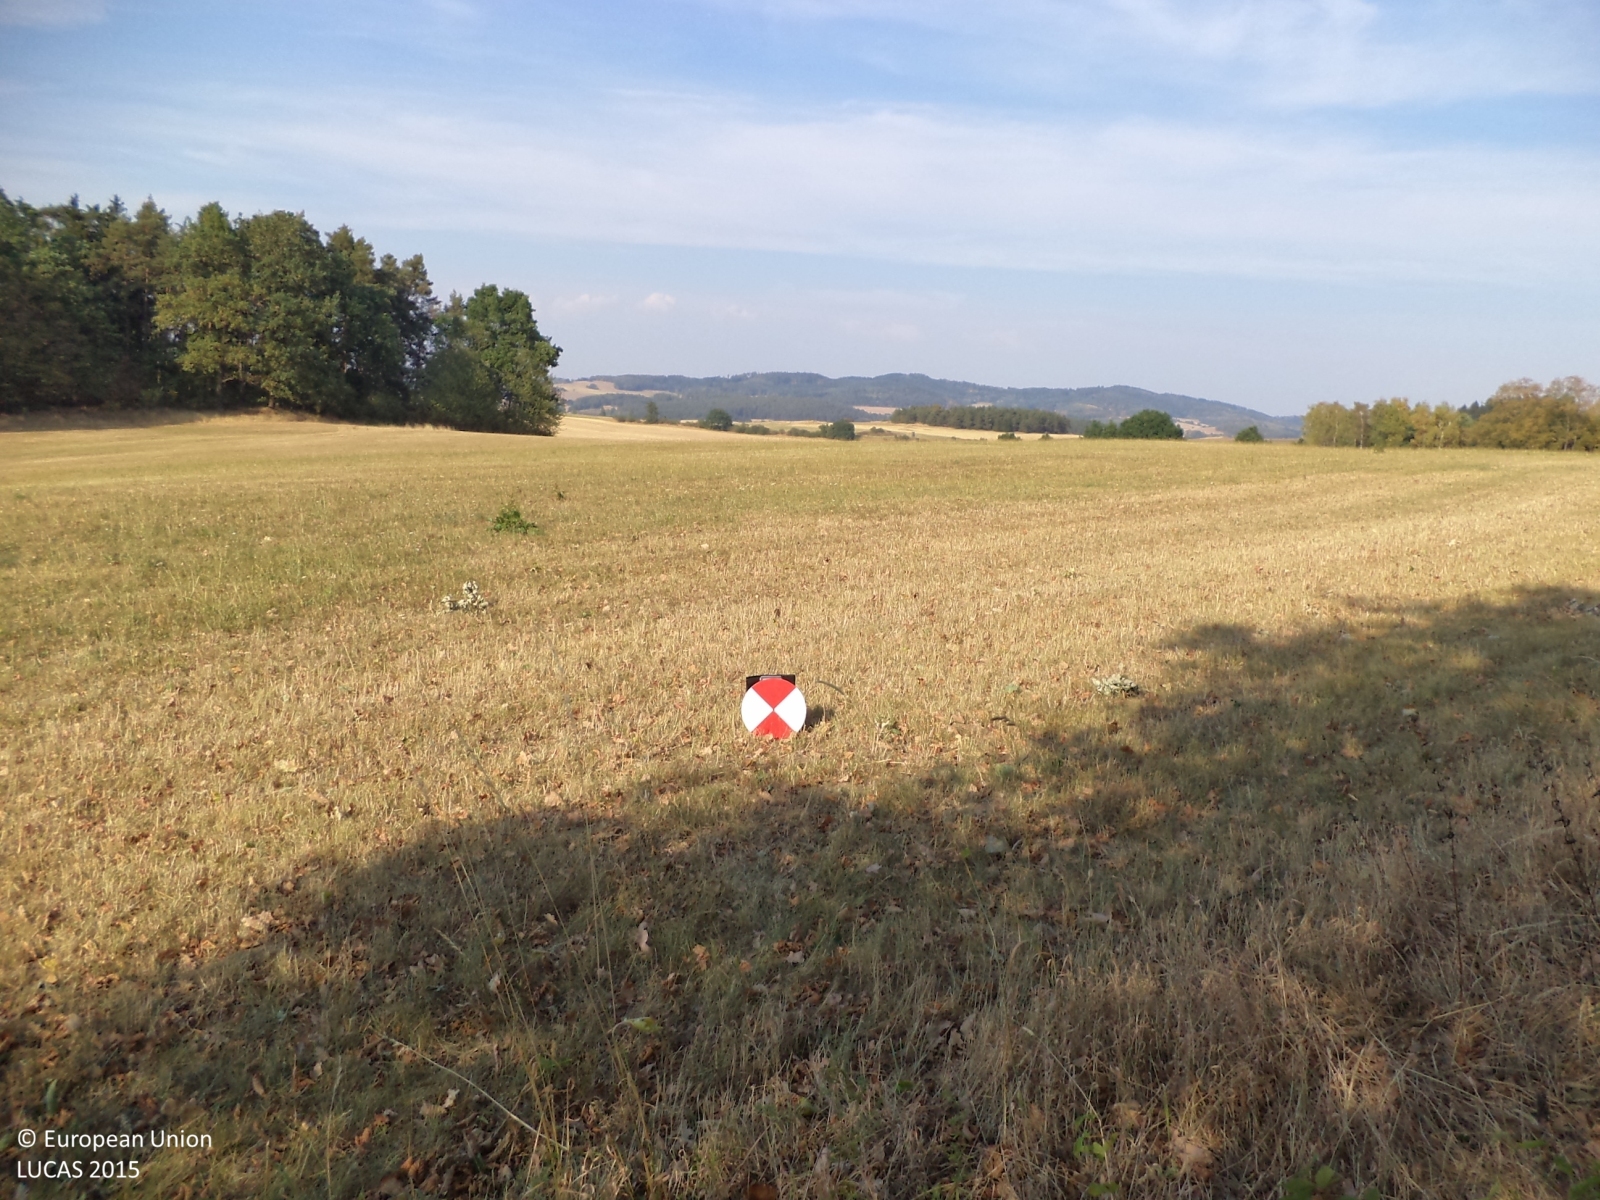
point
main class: Grassland
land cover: Grassland without tree/shrub cover
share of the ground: > 75 %
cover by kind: herbaceous plants 100 %
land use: Agriculture (excluding fallow land and kitchen gardens)
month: August
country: CZ
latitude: 49.5934
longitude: 14.4423
